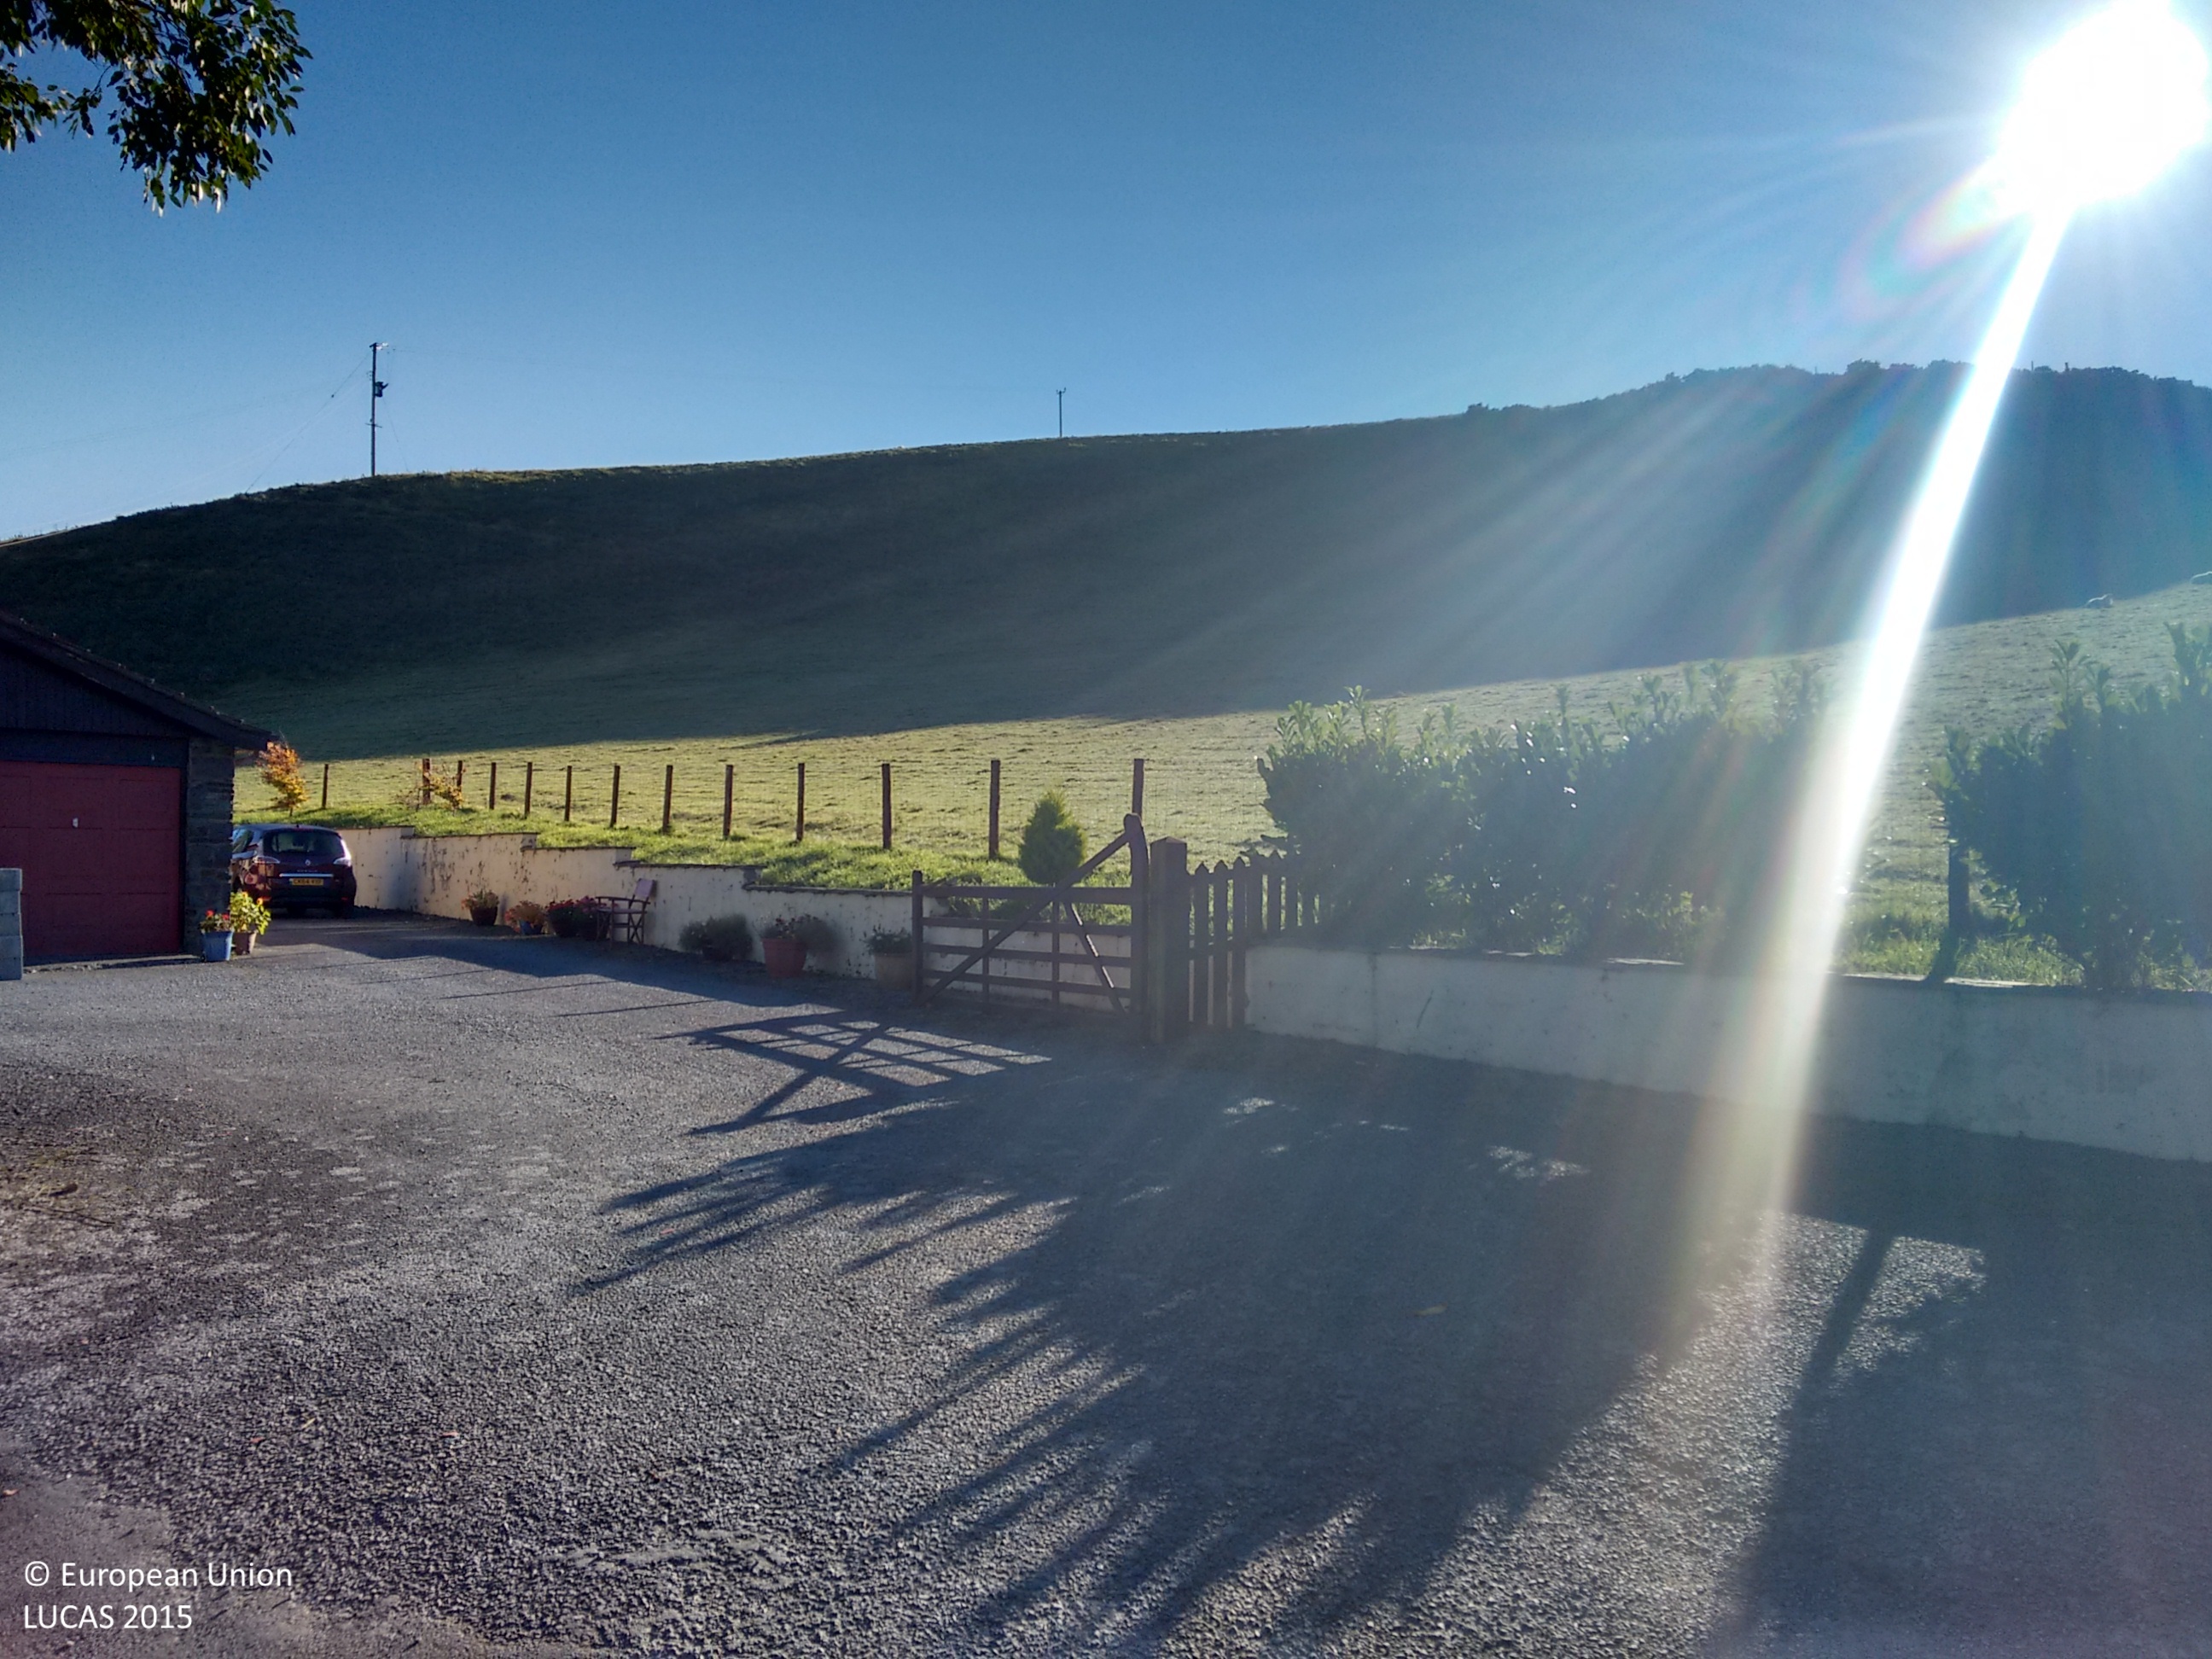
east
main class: Grassland
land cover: Grassland without tree/shrub cover
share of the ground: > 75 %
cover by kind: herbaceous plants 100 %
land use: Agriculture (excluding fallow land and kitchen gardens)
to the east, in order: Grassland without tree/shrub cover; Fences; Managed hedges; Grass margins; Paved roads, cycling and walking lanes; Grass margins; Electric lines; Managed hedges; Fences; Shruby margins; Grassland without tree/shrub cover; Managed hedges; Grassland without tree/shrub cover; Electric lines; Grassland without tree/shrub cover
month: October
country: GB
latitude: 52.3955
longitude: -4.0419
